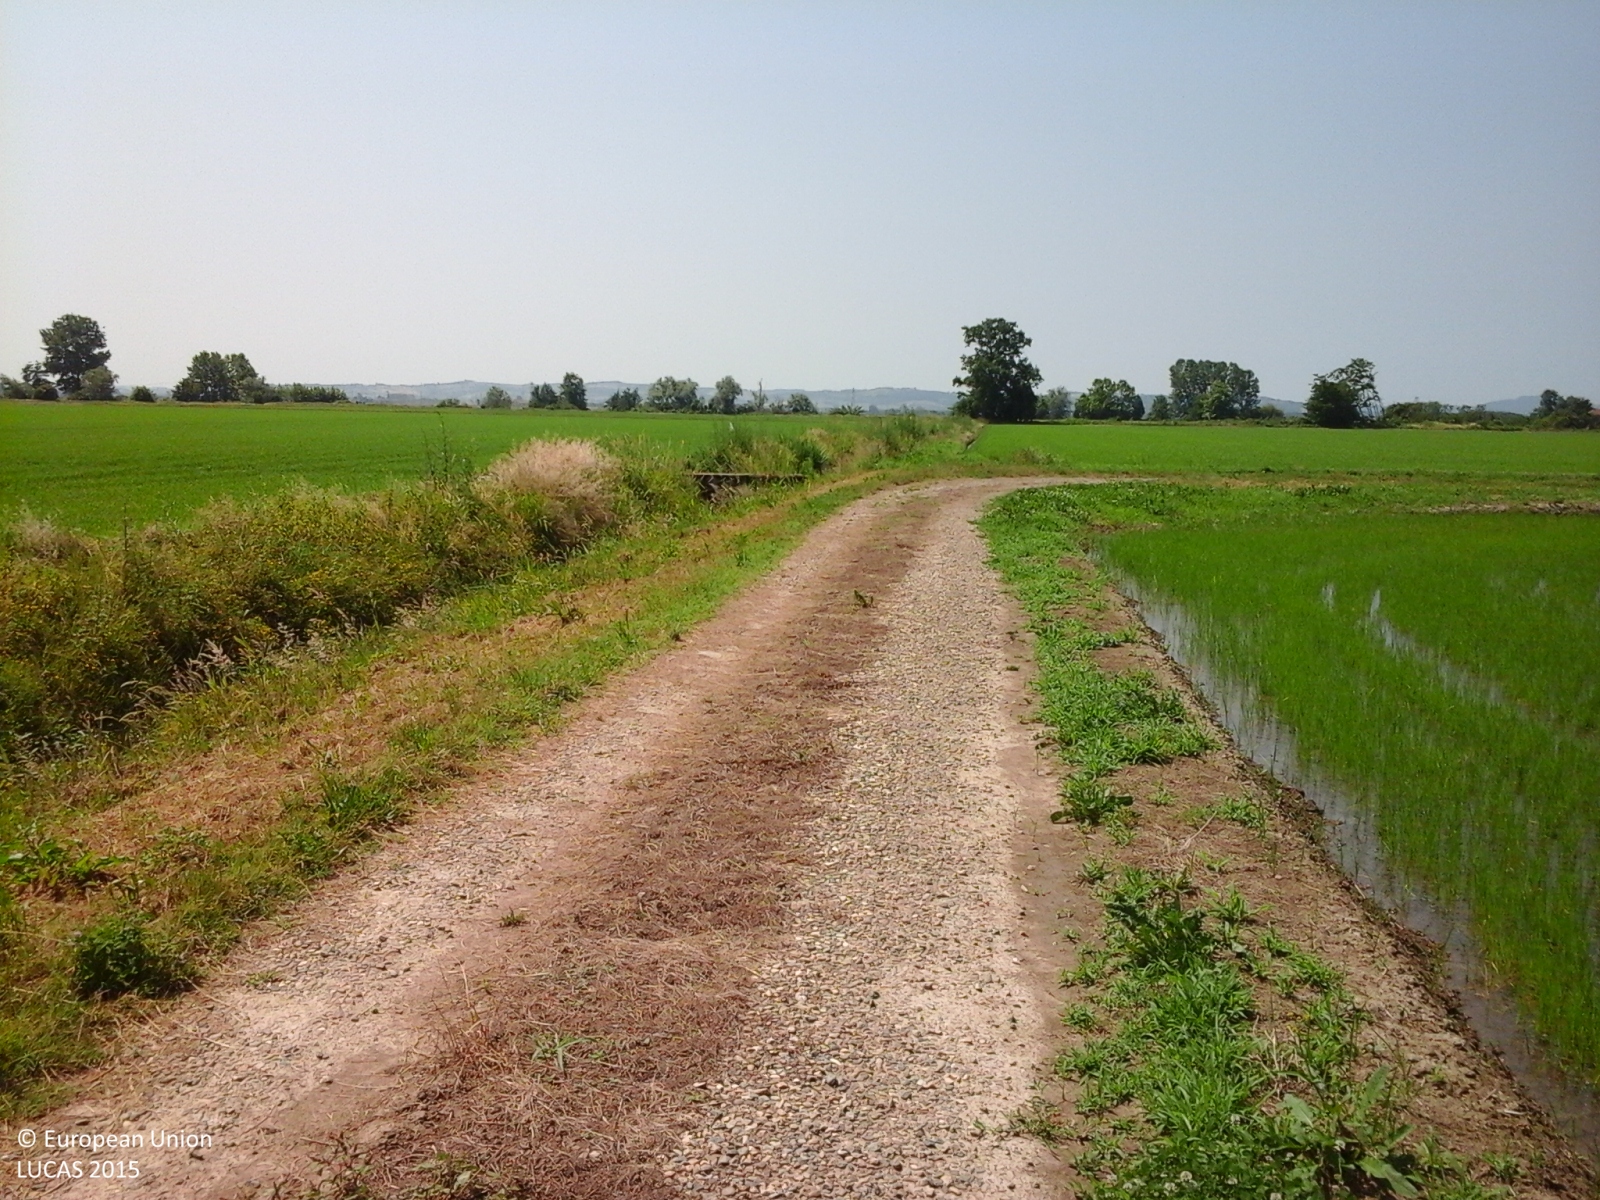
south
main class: Cropland
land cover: Rice
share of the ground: 25 - 50 %
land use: Agriculture (excluding fallow land and kitchen gardens)
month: June
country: IT
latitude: 45.2224
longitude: 8.4363
